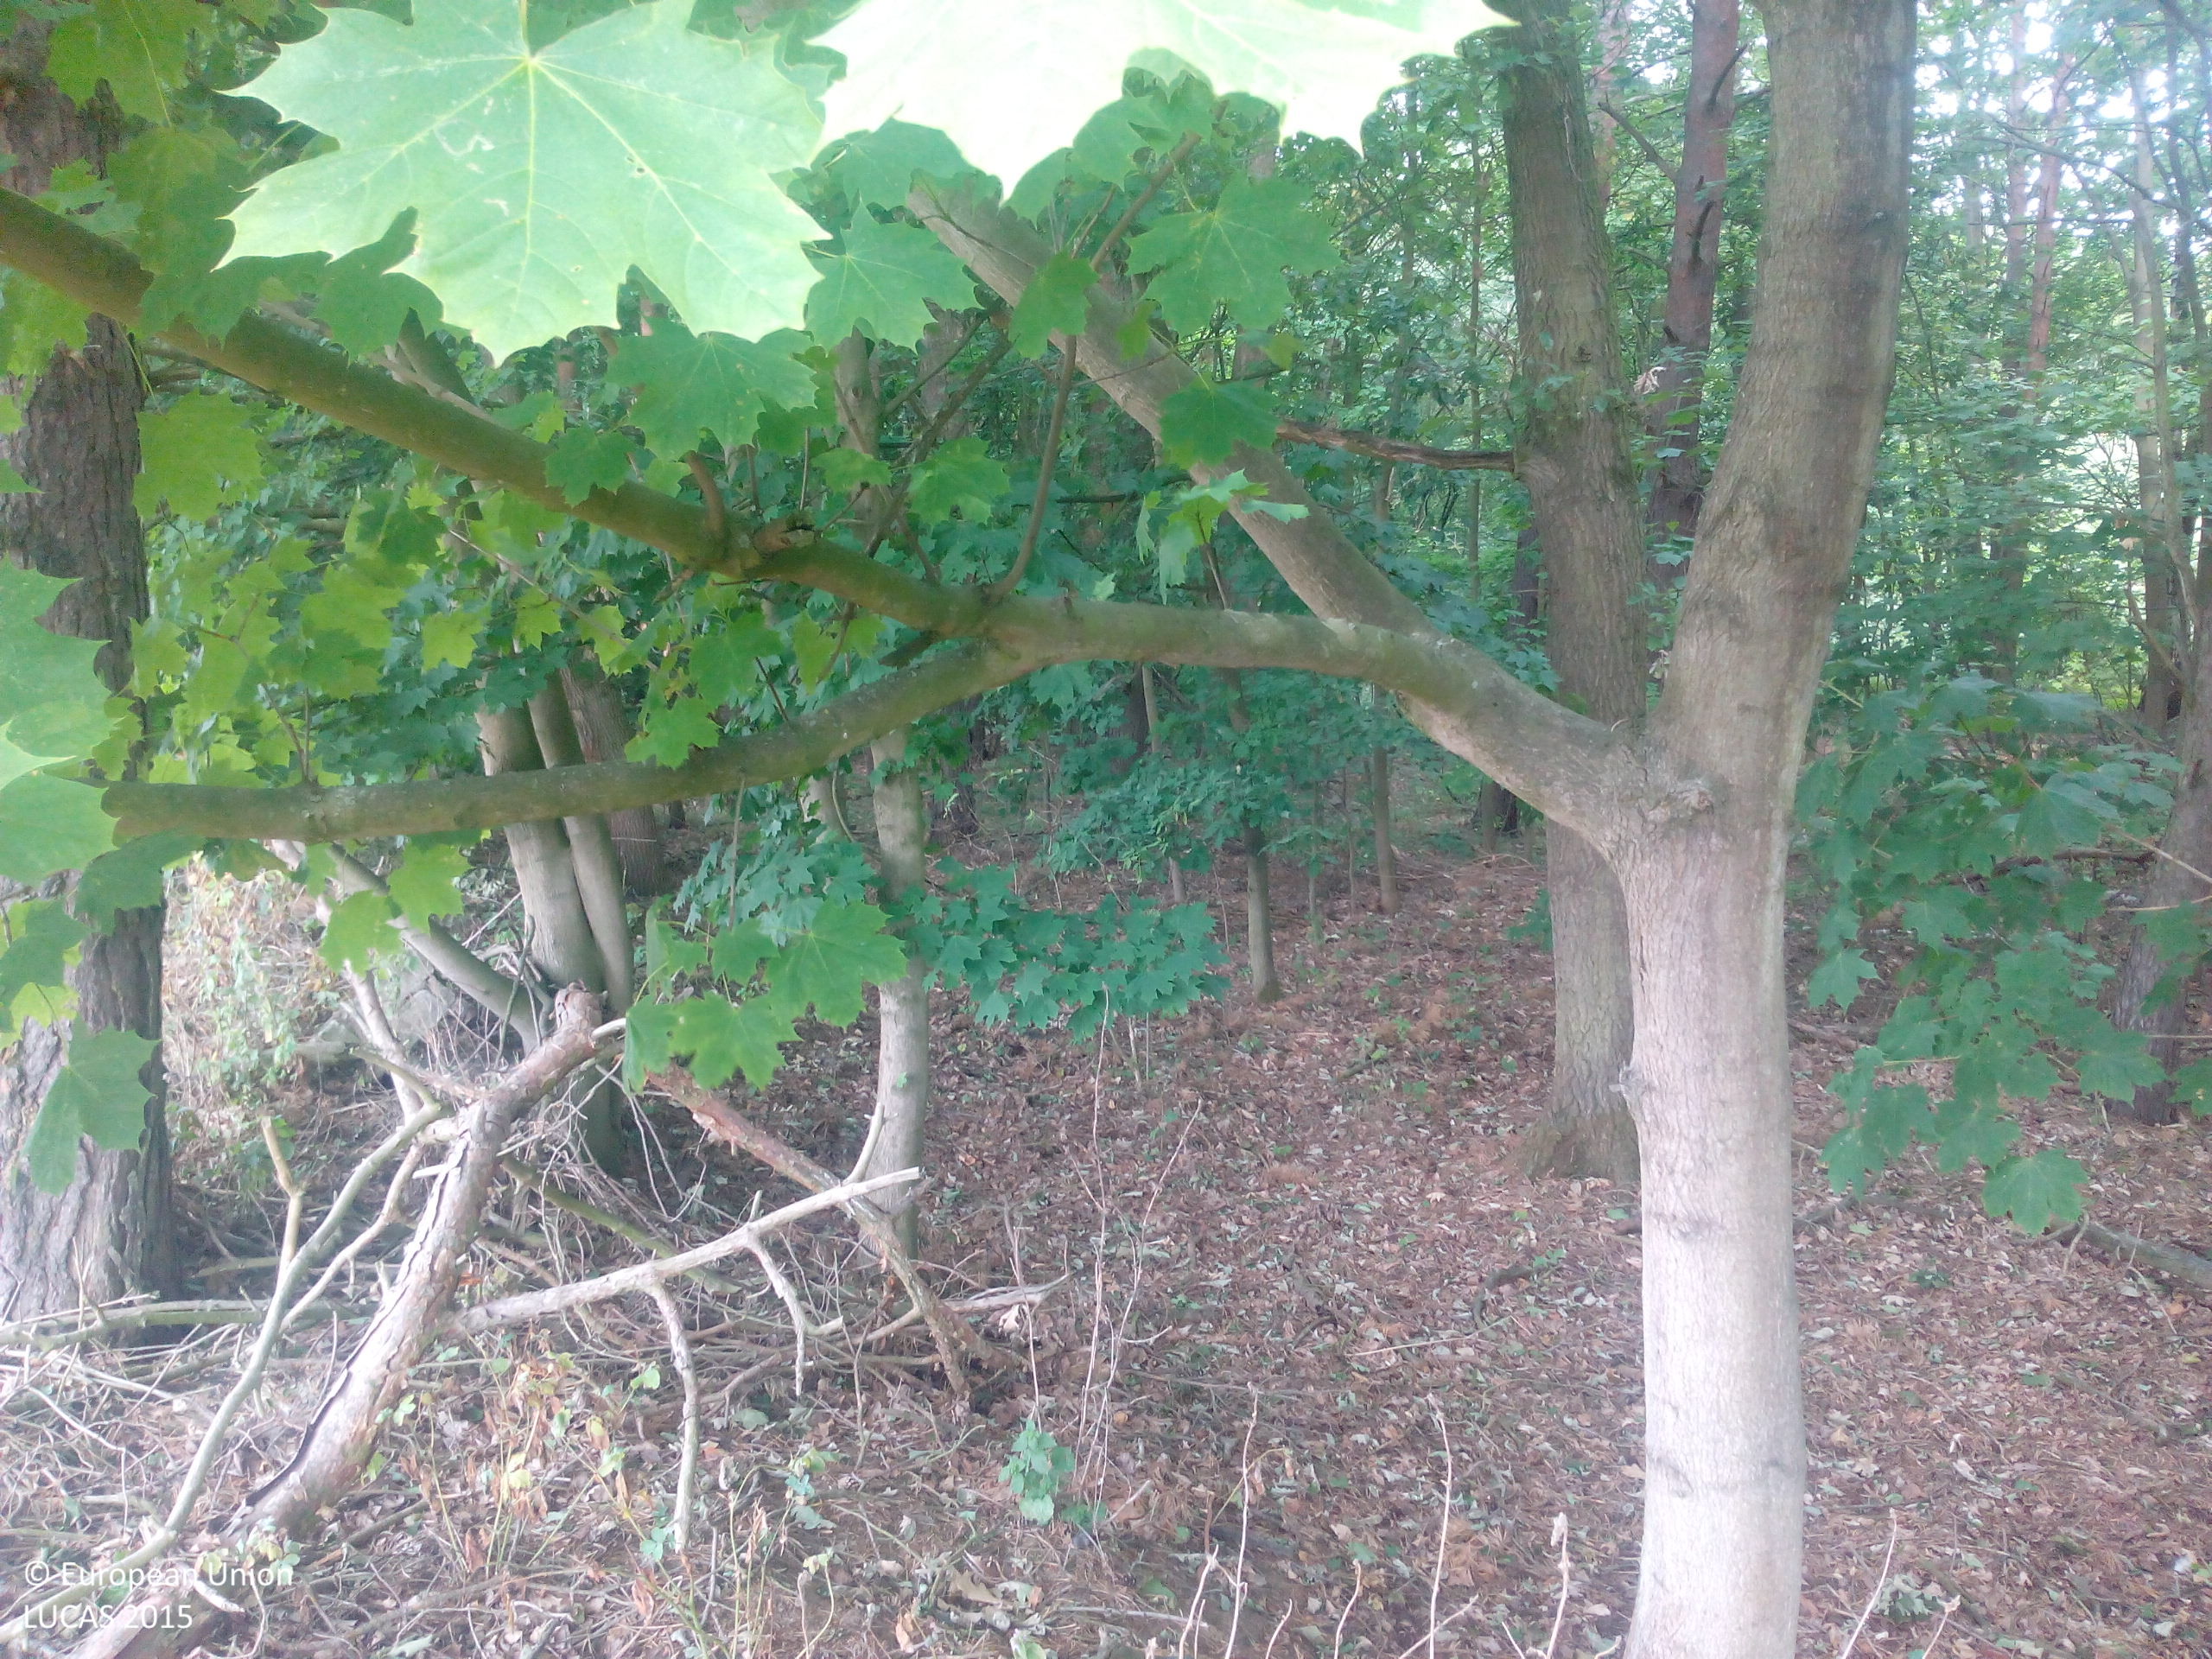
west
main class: Woodland
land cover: Pine dominated mixed woodland
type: hemiboreal forest and nemoral coniferous forest and mixed broadleaved-coniferous forest
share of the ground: > 75 %
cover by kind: coniferous forest trees 70 %, broadleaved forest trees 30 %
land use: Forestry
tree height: > 5 m
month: July
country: DE
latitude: 52.5698
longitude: 11.1357
